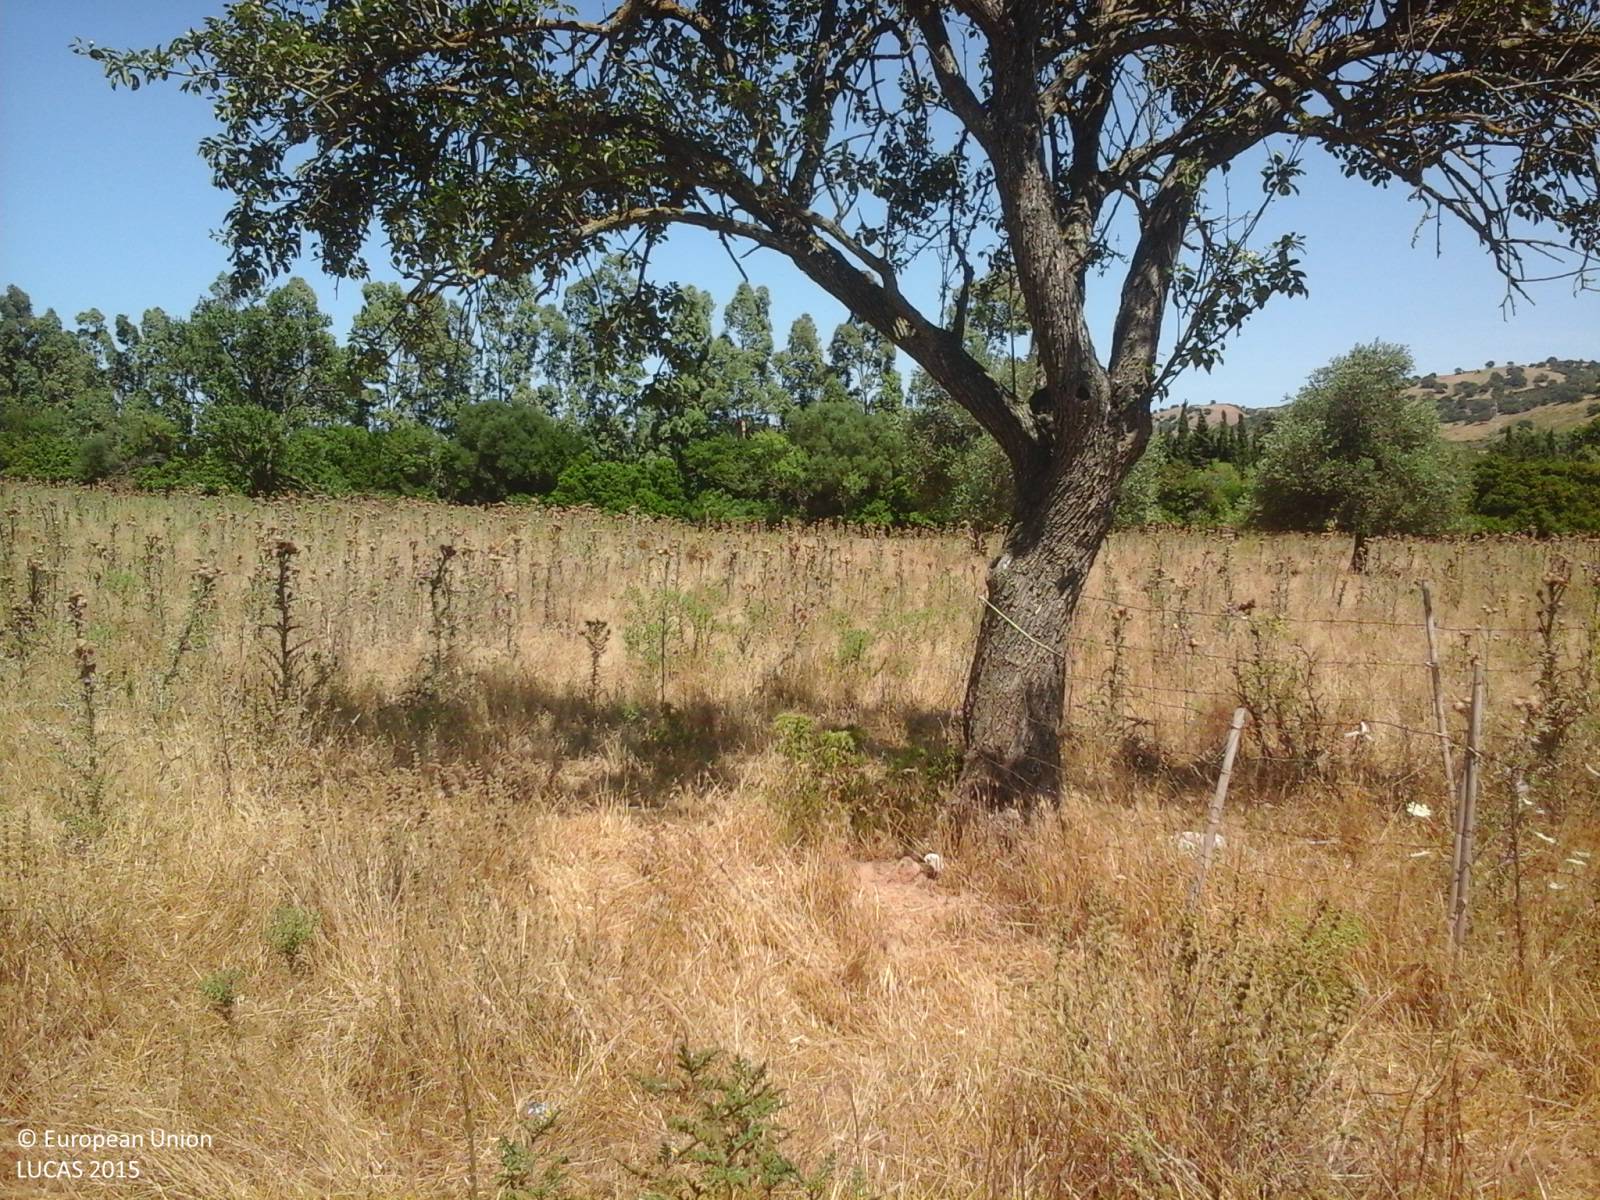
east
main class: Grassland
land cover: Grassland without tree/shrub cover
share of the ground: > 75 %
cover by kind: herbaceous plants 90 %, shrubs 5 %, unconsolidated bare surface 5 %
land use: Agriculture (excluding fallow land and kitchen gardens)
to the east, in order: Grassland without tree/shrub cover; Dry stone walls; Fences; Abandoned hedges; Tracks; Abandoned hedges; Fences; Other fruit trees and berries; Tomatoes; Broadleaved woodland; Grassland without tree/shrub cover; Fences; Abandoned hedges; Grassland without tree/shrub cover
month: June
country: IT
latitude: 40.5564
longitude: 9.6827
